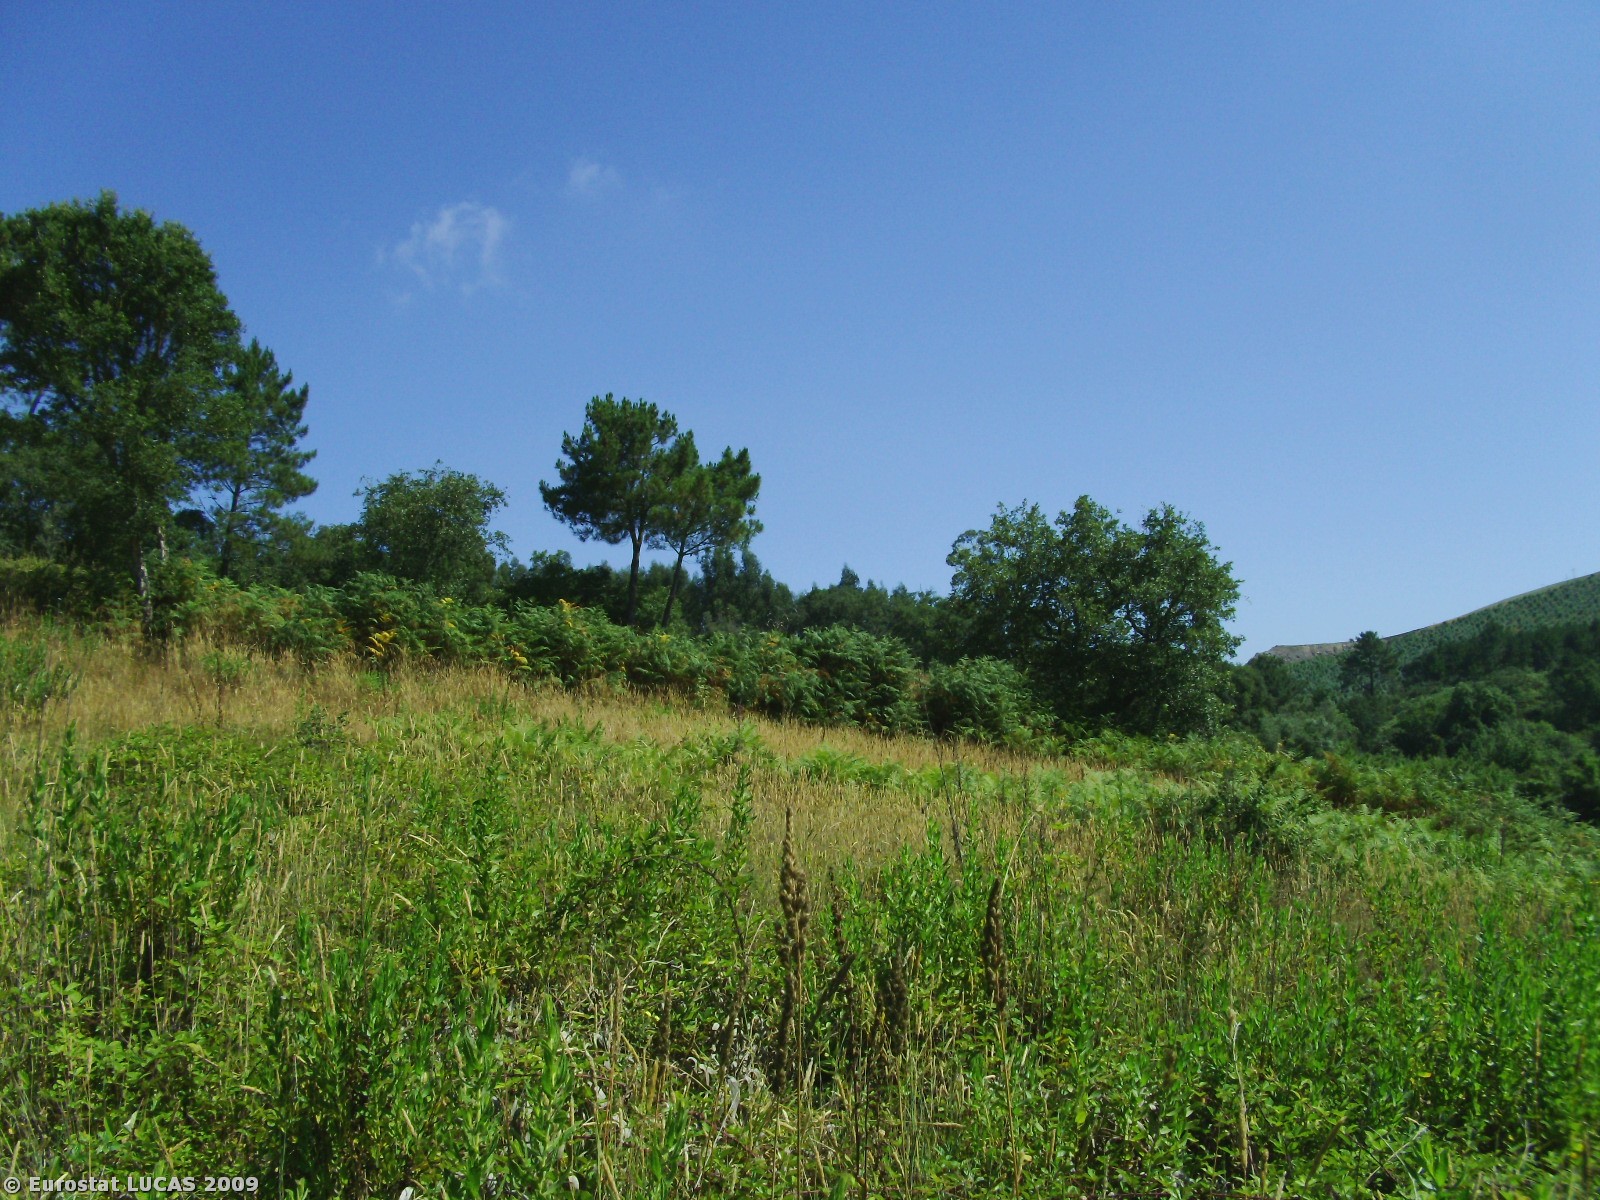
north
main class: Grassland
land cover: Spontaneously vegetated surfaces
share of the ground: > 75 %
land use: Fallow land
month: July
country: PT
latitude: 38.9258
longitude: -9.2890
